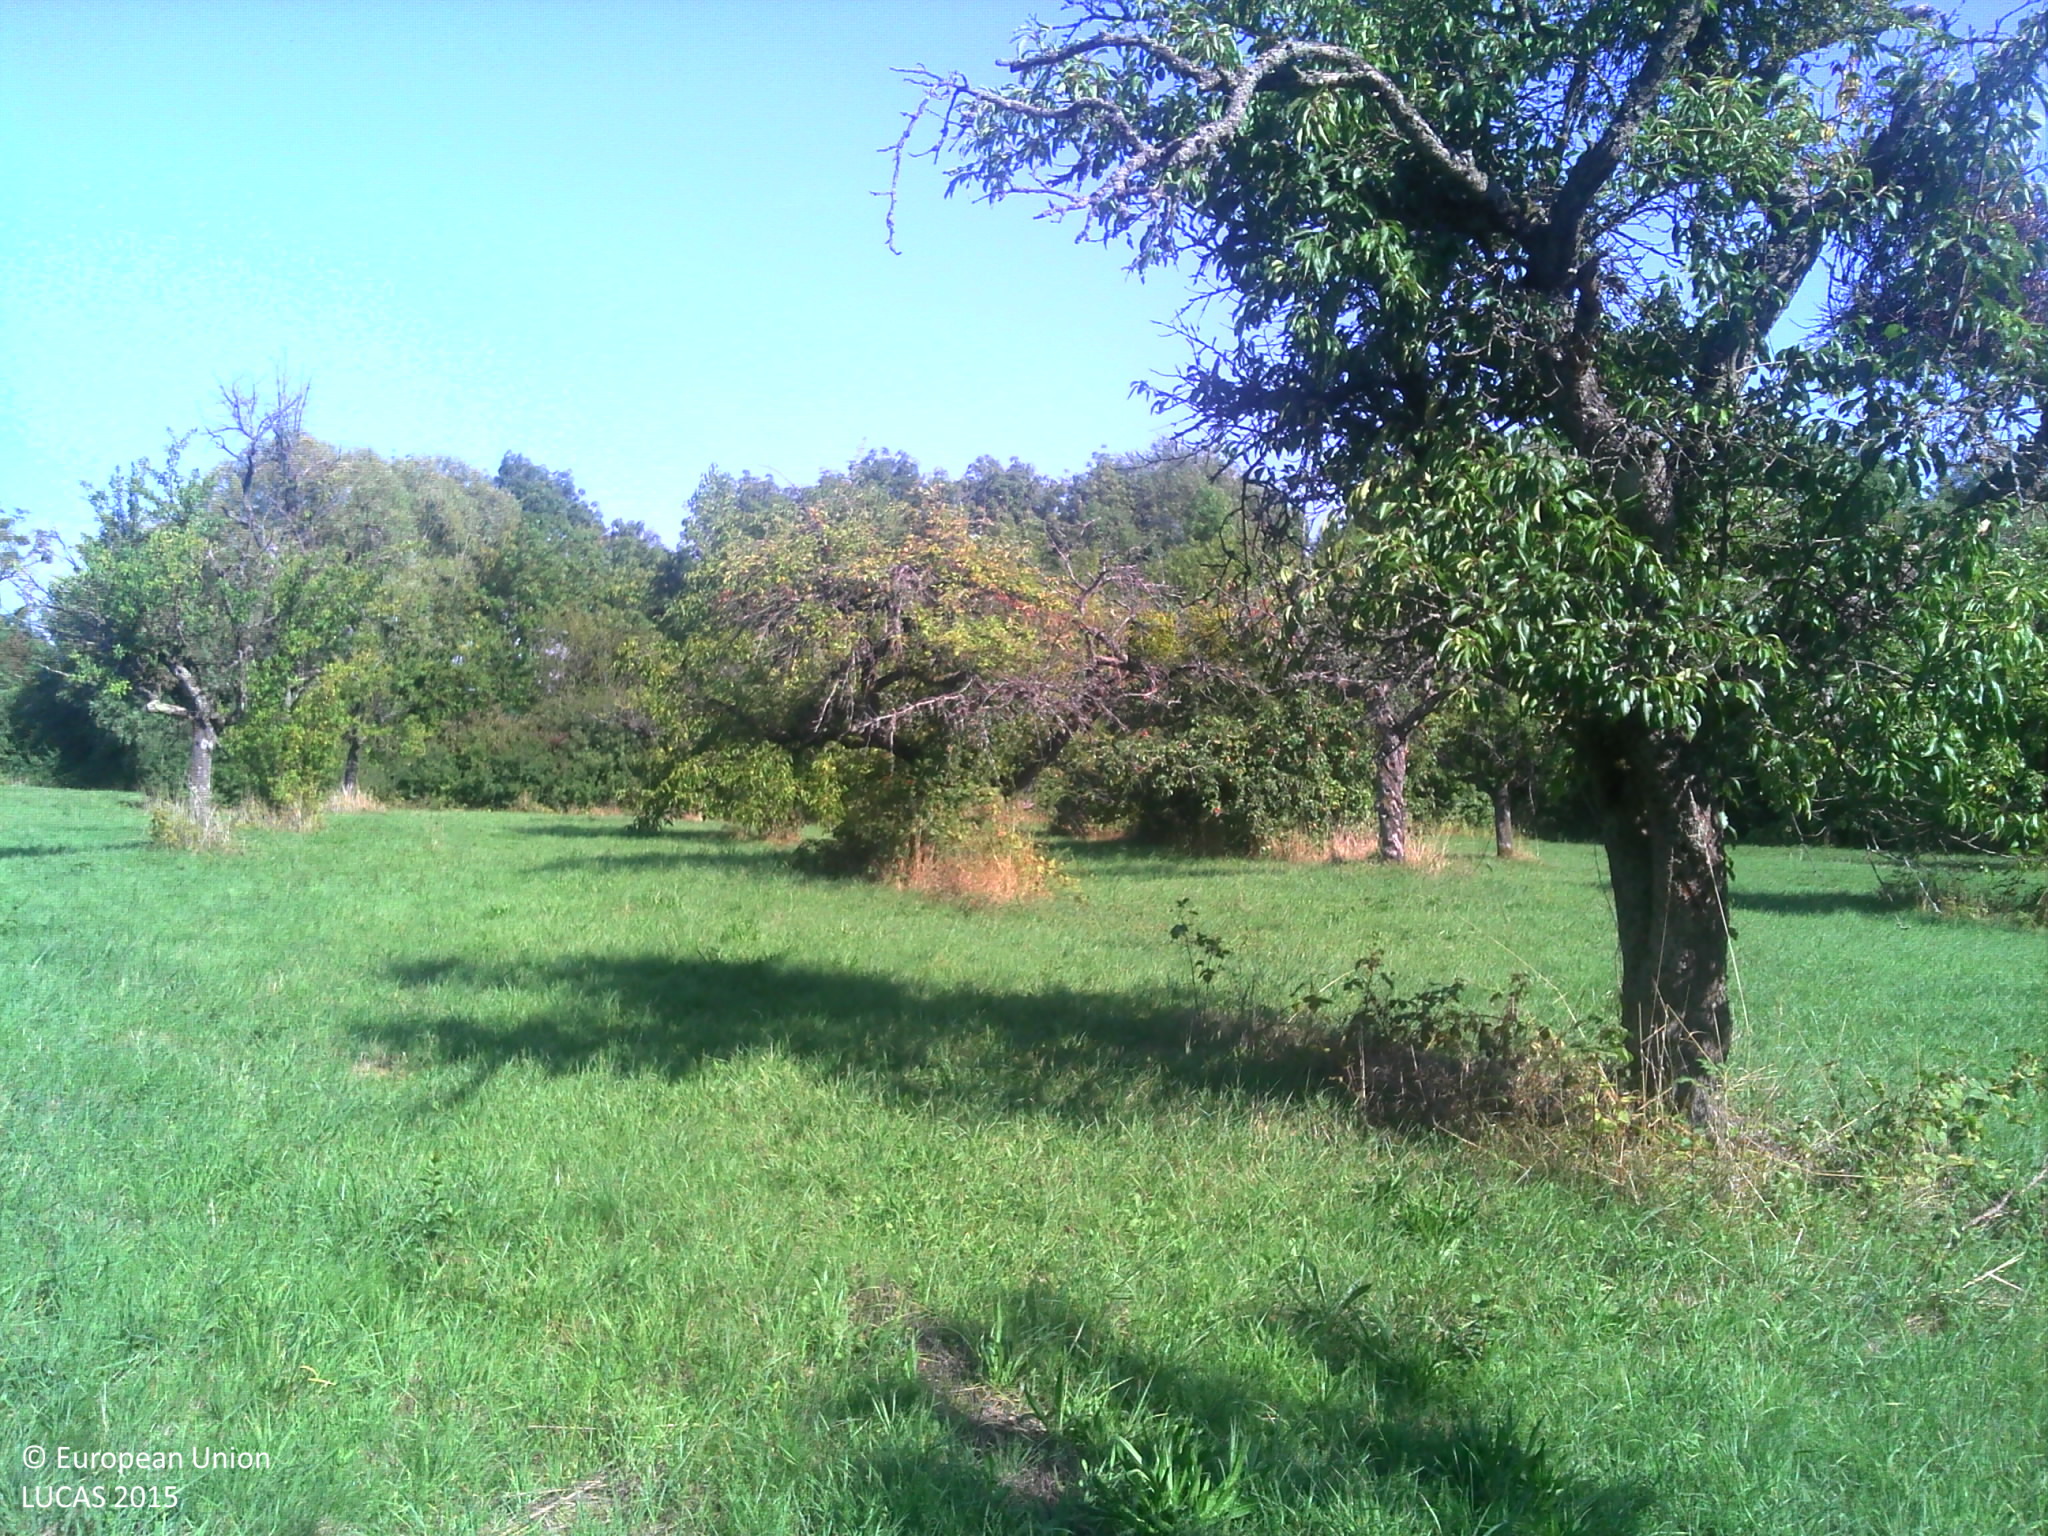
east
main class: Cropland
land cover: Other fruit trees and berries
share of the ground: > 75 %
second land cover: Grassland without tree/shrub cover
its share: > 75 %
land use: Agriculture (excluding fallow land and kitchen gardens)
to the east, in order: Other fruit trees and berries; Grassland without tree/shrub cover; Apple fruit; Broadleaved woodland; Ditches and canals; Broadleaved woodland; Tracks; Broadleaved woodland; Electric lines; Grass margins; Tracks; Broadleaved woodland; Ditches and canals; Groves; Temporary grasslands; Grassland without tree/shrub cover
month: September
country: FR
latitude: 48.8264
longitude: 6.2541
